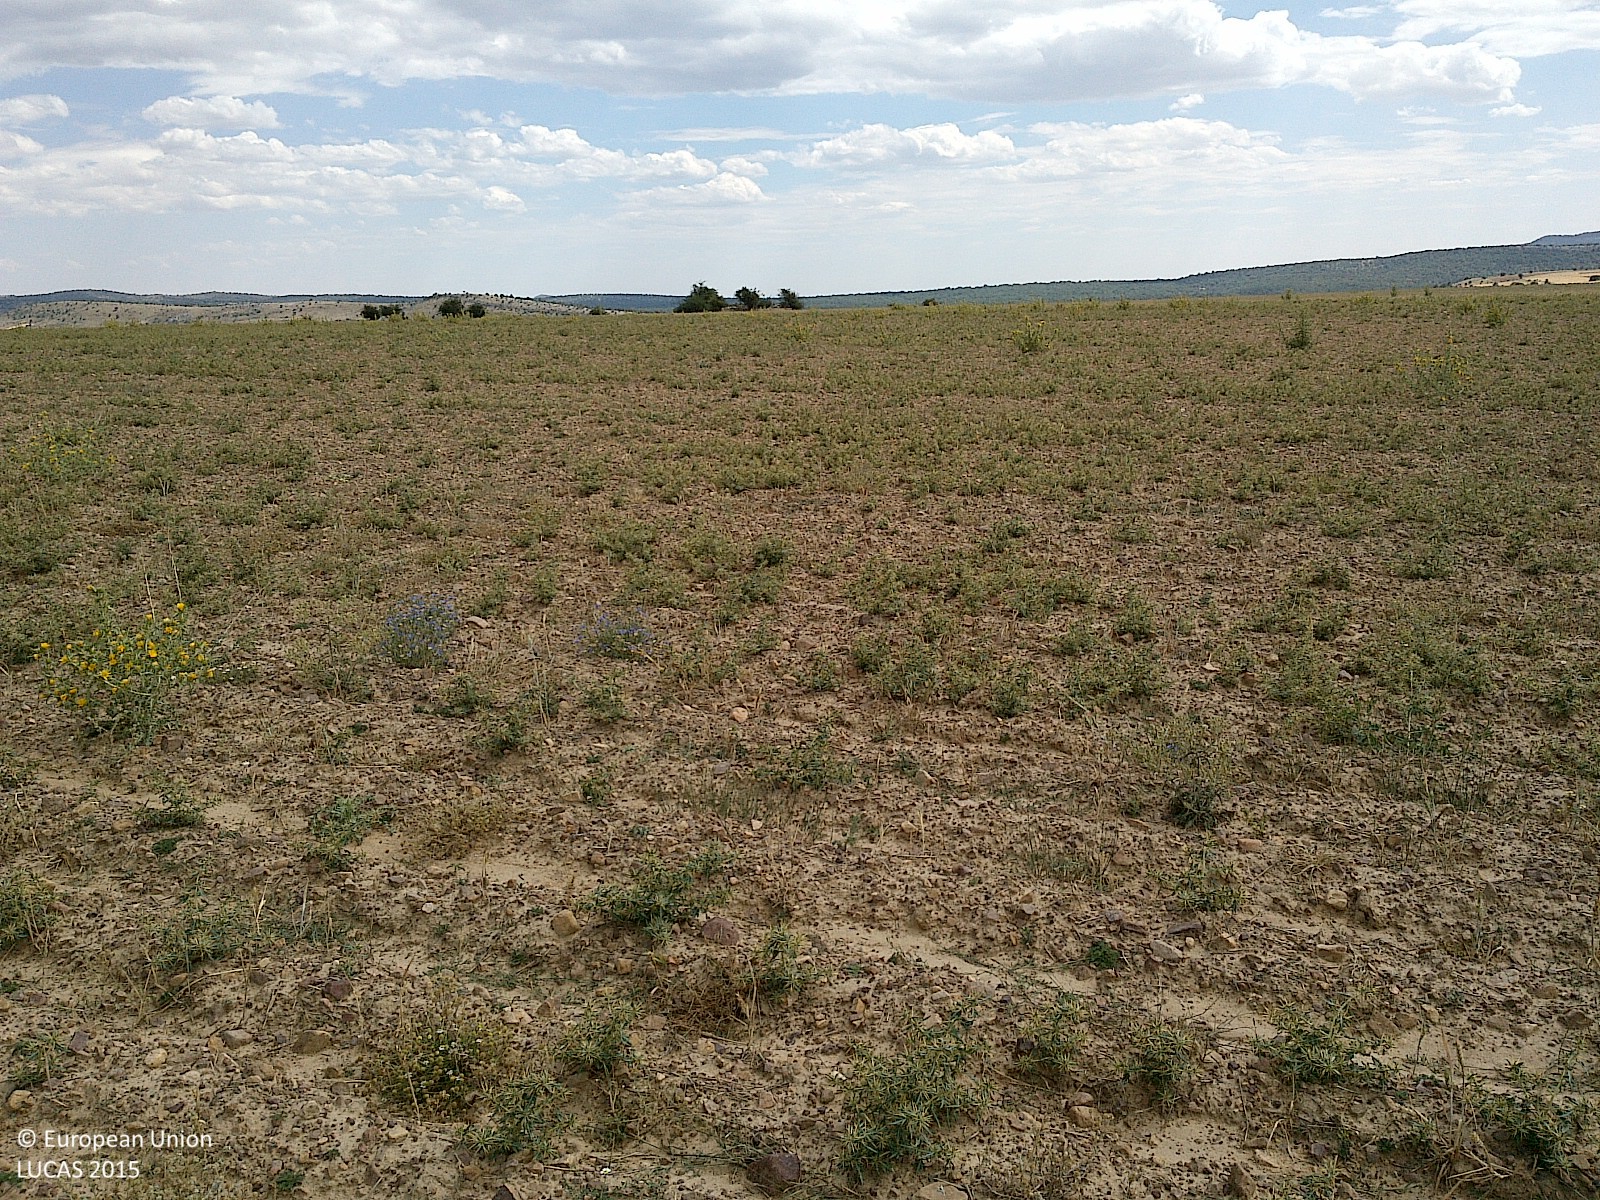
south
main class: Grassland
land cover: Spontaneously vegetated surfaces
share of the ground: 10 - 25 %
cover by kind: unconsolidated bare surface 85 %, herbaceous plants 15 %
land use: Fallow land
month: July
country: ES
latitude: 41.6721
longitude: -1.9345
